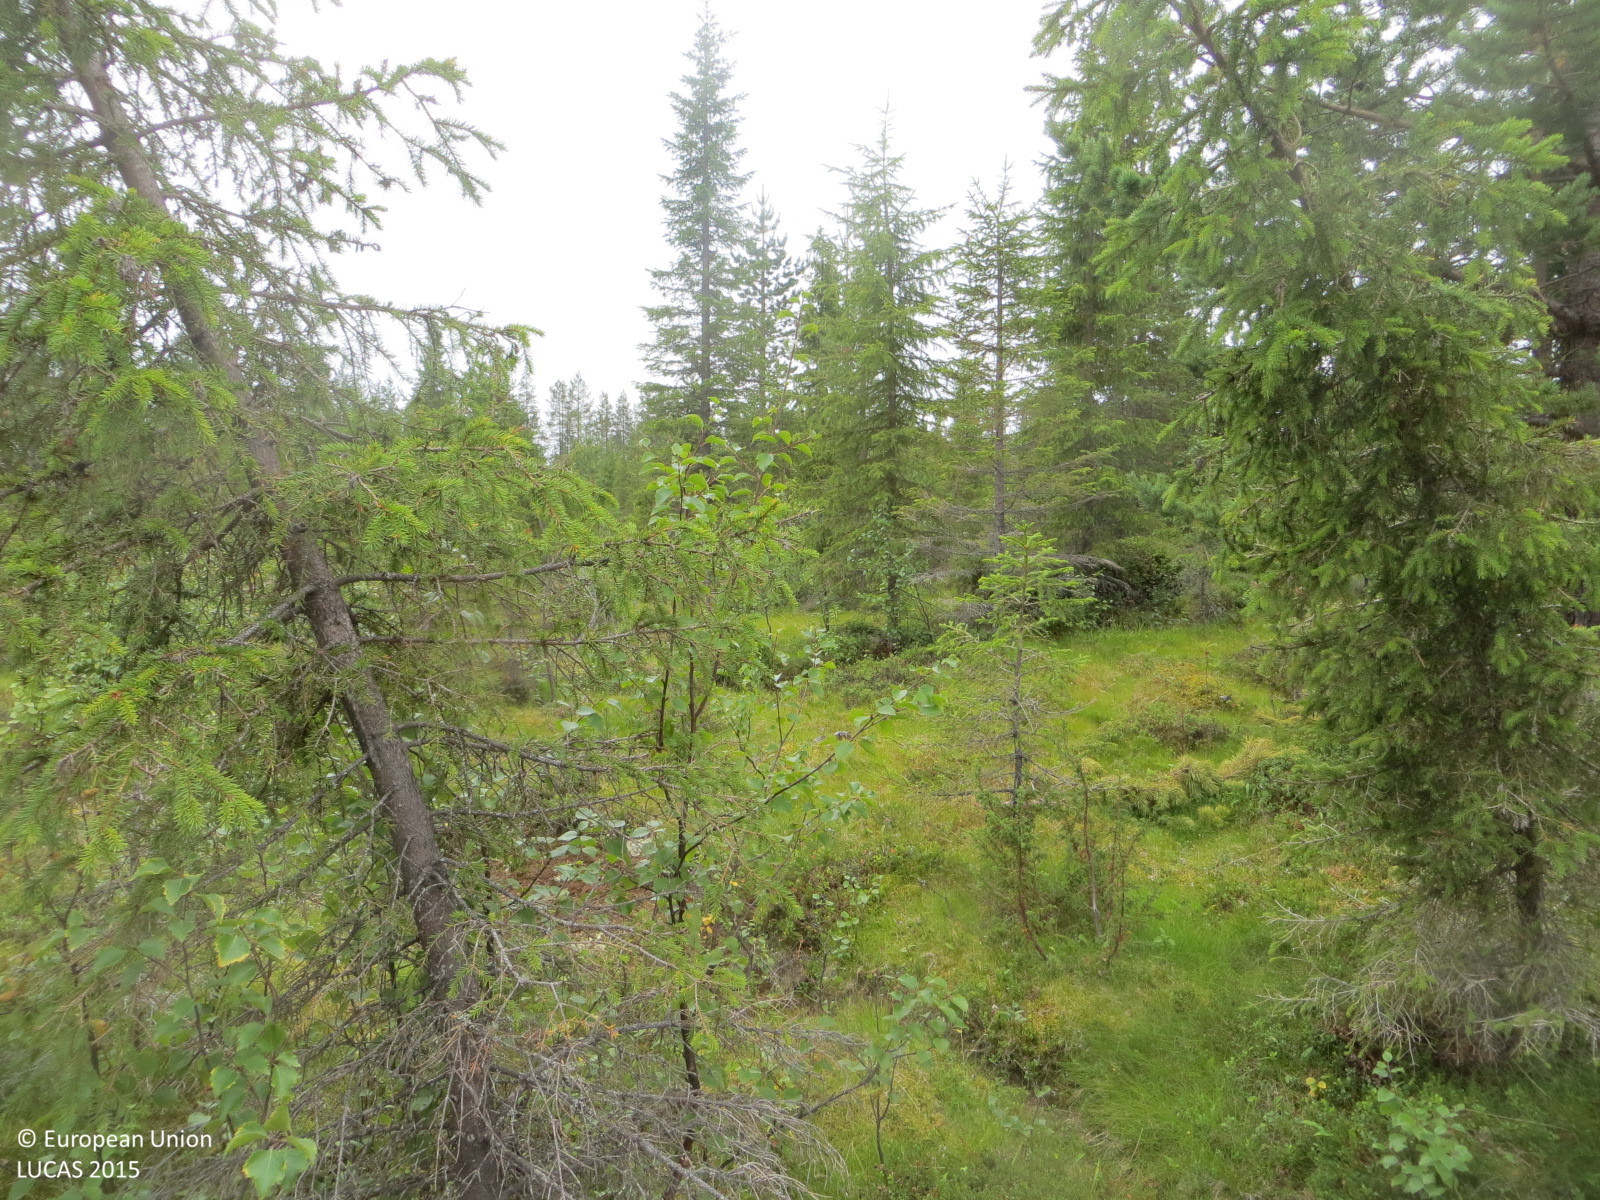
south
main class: Woodland
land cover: Spruce dominated coniferous woodland
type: boreal forest
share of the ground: 50 - 75 %
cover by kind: coniferous forest trees 50 %, herbaceous plants 25 %, shrubs 20 %, broadleaved forest trees 5 %
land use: Forestry
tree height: > 5 m
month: August
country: FI
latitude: 68.0351
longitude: 25.3463
